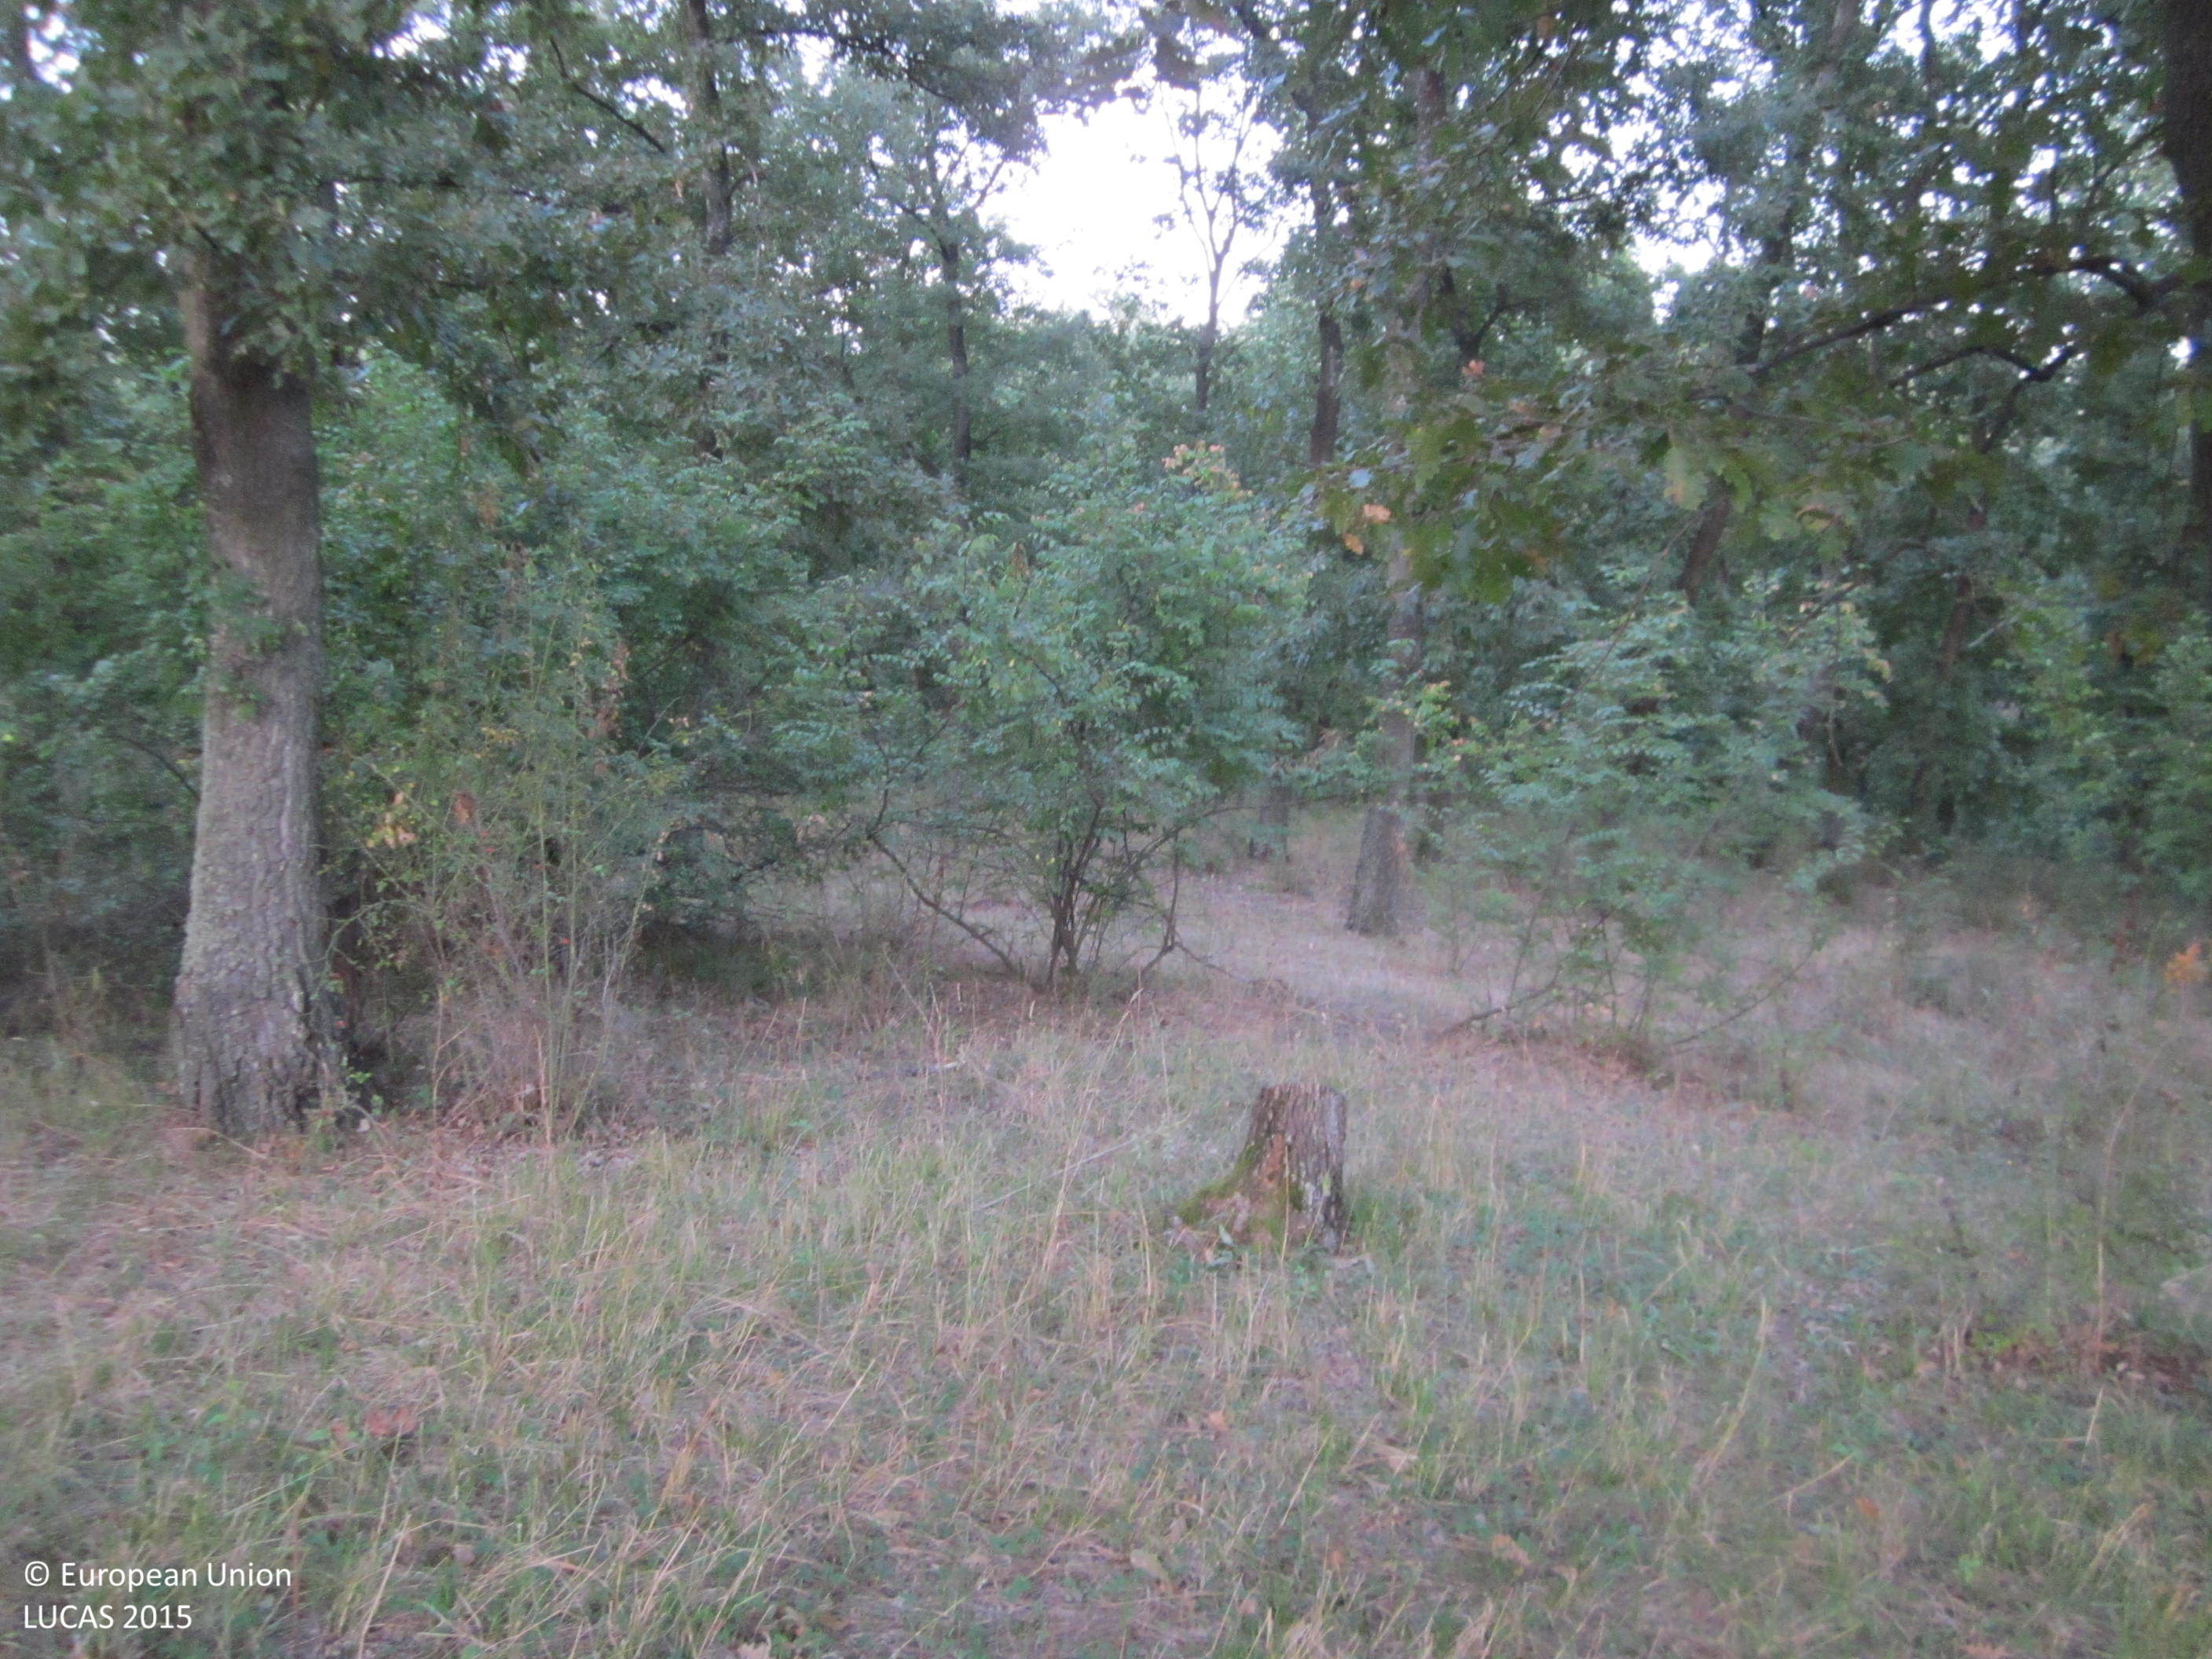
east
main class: Woodland
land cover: Broadleaved woodland
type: thermophilous deciduous forest
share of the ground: 50 - 75 %
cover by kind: broadleaved forest trees 70 %, herbaceous plants 30 %
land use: Forestry
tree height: > 5 m
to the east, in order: Broadleaved woodland; Rivers and streams; Broadleaved woodland; Tracks; Broadleaved woodland
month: September
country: BG
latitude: 42.6599
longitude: 27.1035
